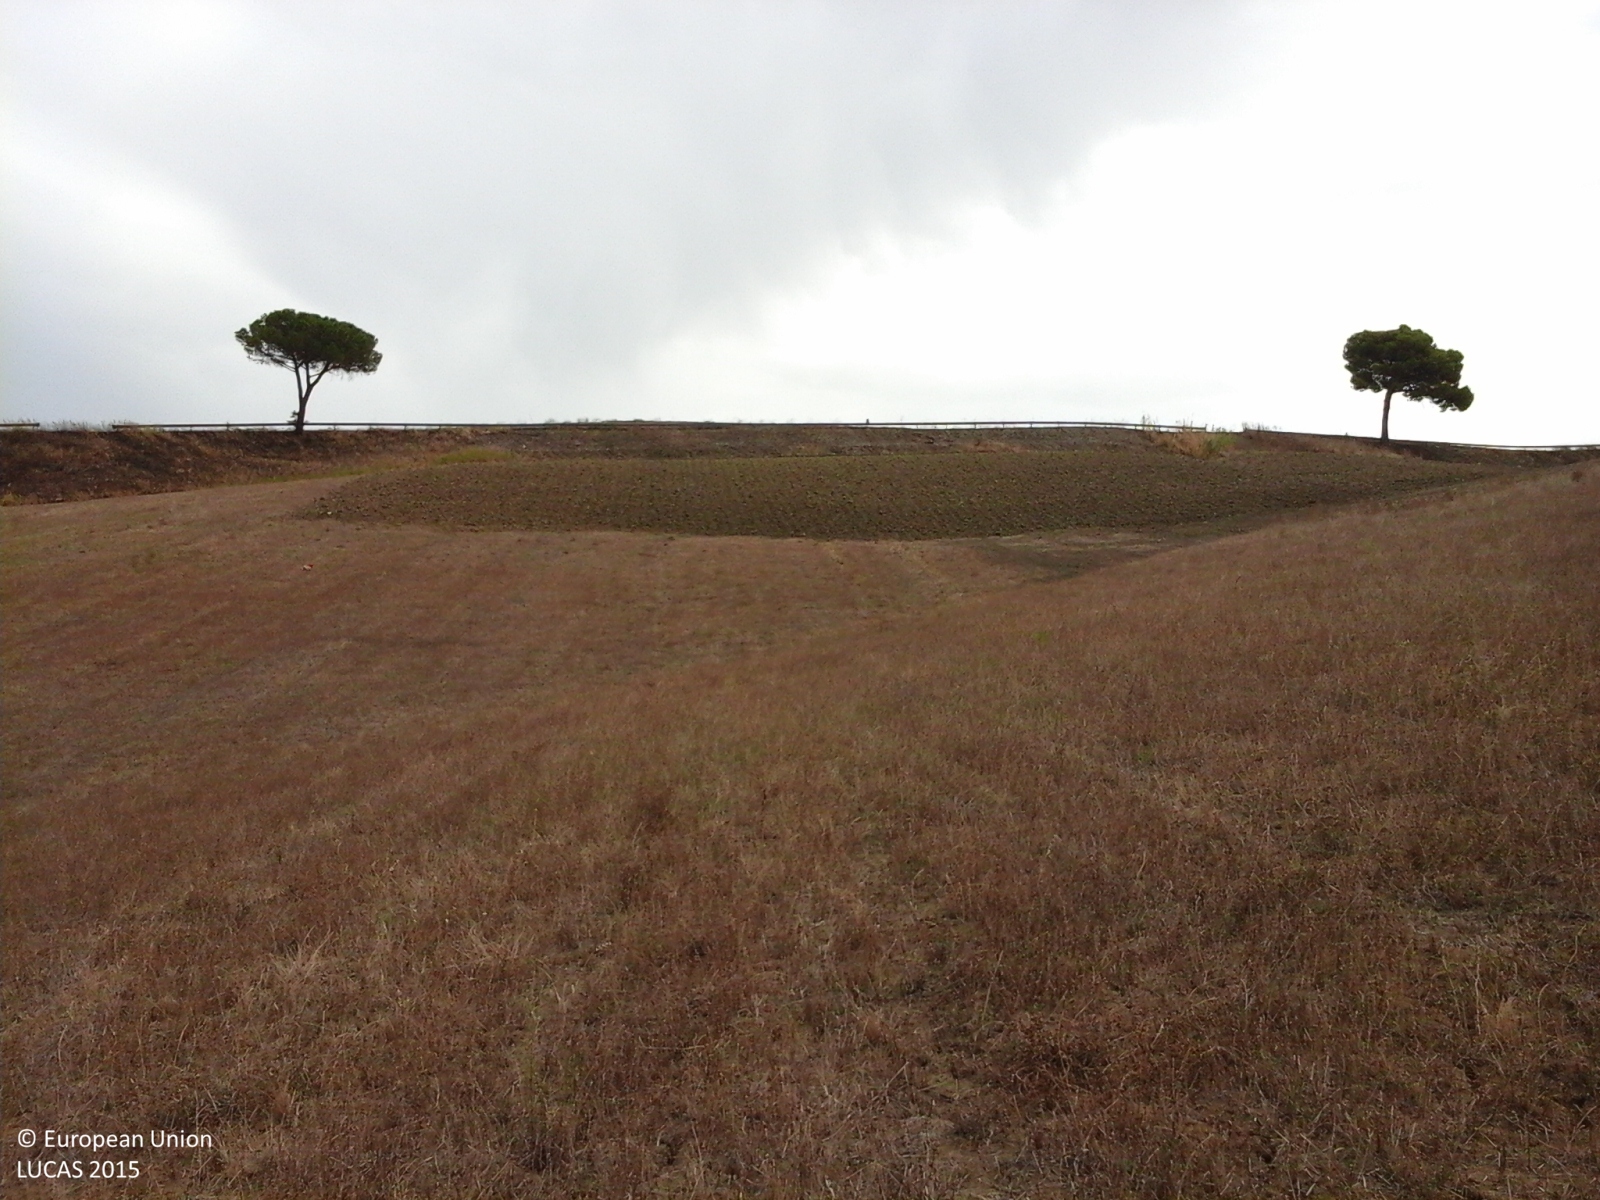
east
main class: Cropland
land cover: Temporary grasslands
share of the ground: > 75 %
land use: Agriculture (excluding fallow land and kitchen gardens)
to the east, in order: Temporary grasslands; Other bare soil; Grassland without tree/shrub cover; Paved roads, cycling and walking lanes; Grass margins; Dry pulses
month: September
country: IT
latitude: 41.8353
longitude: 15.1499
